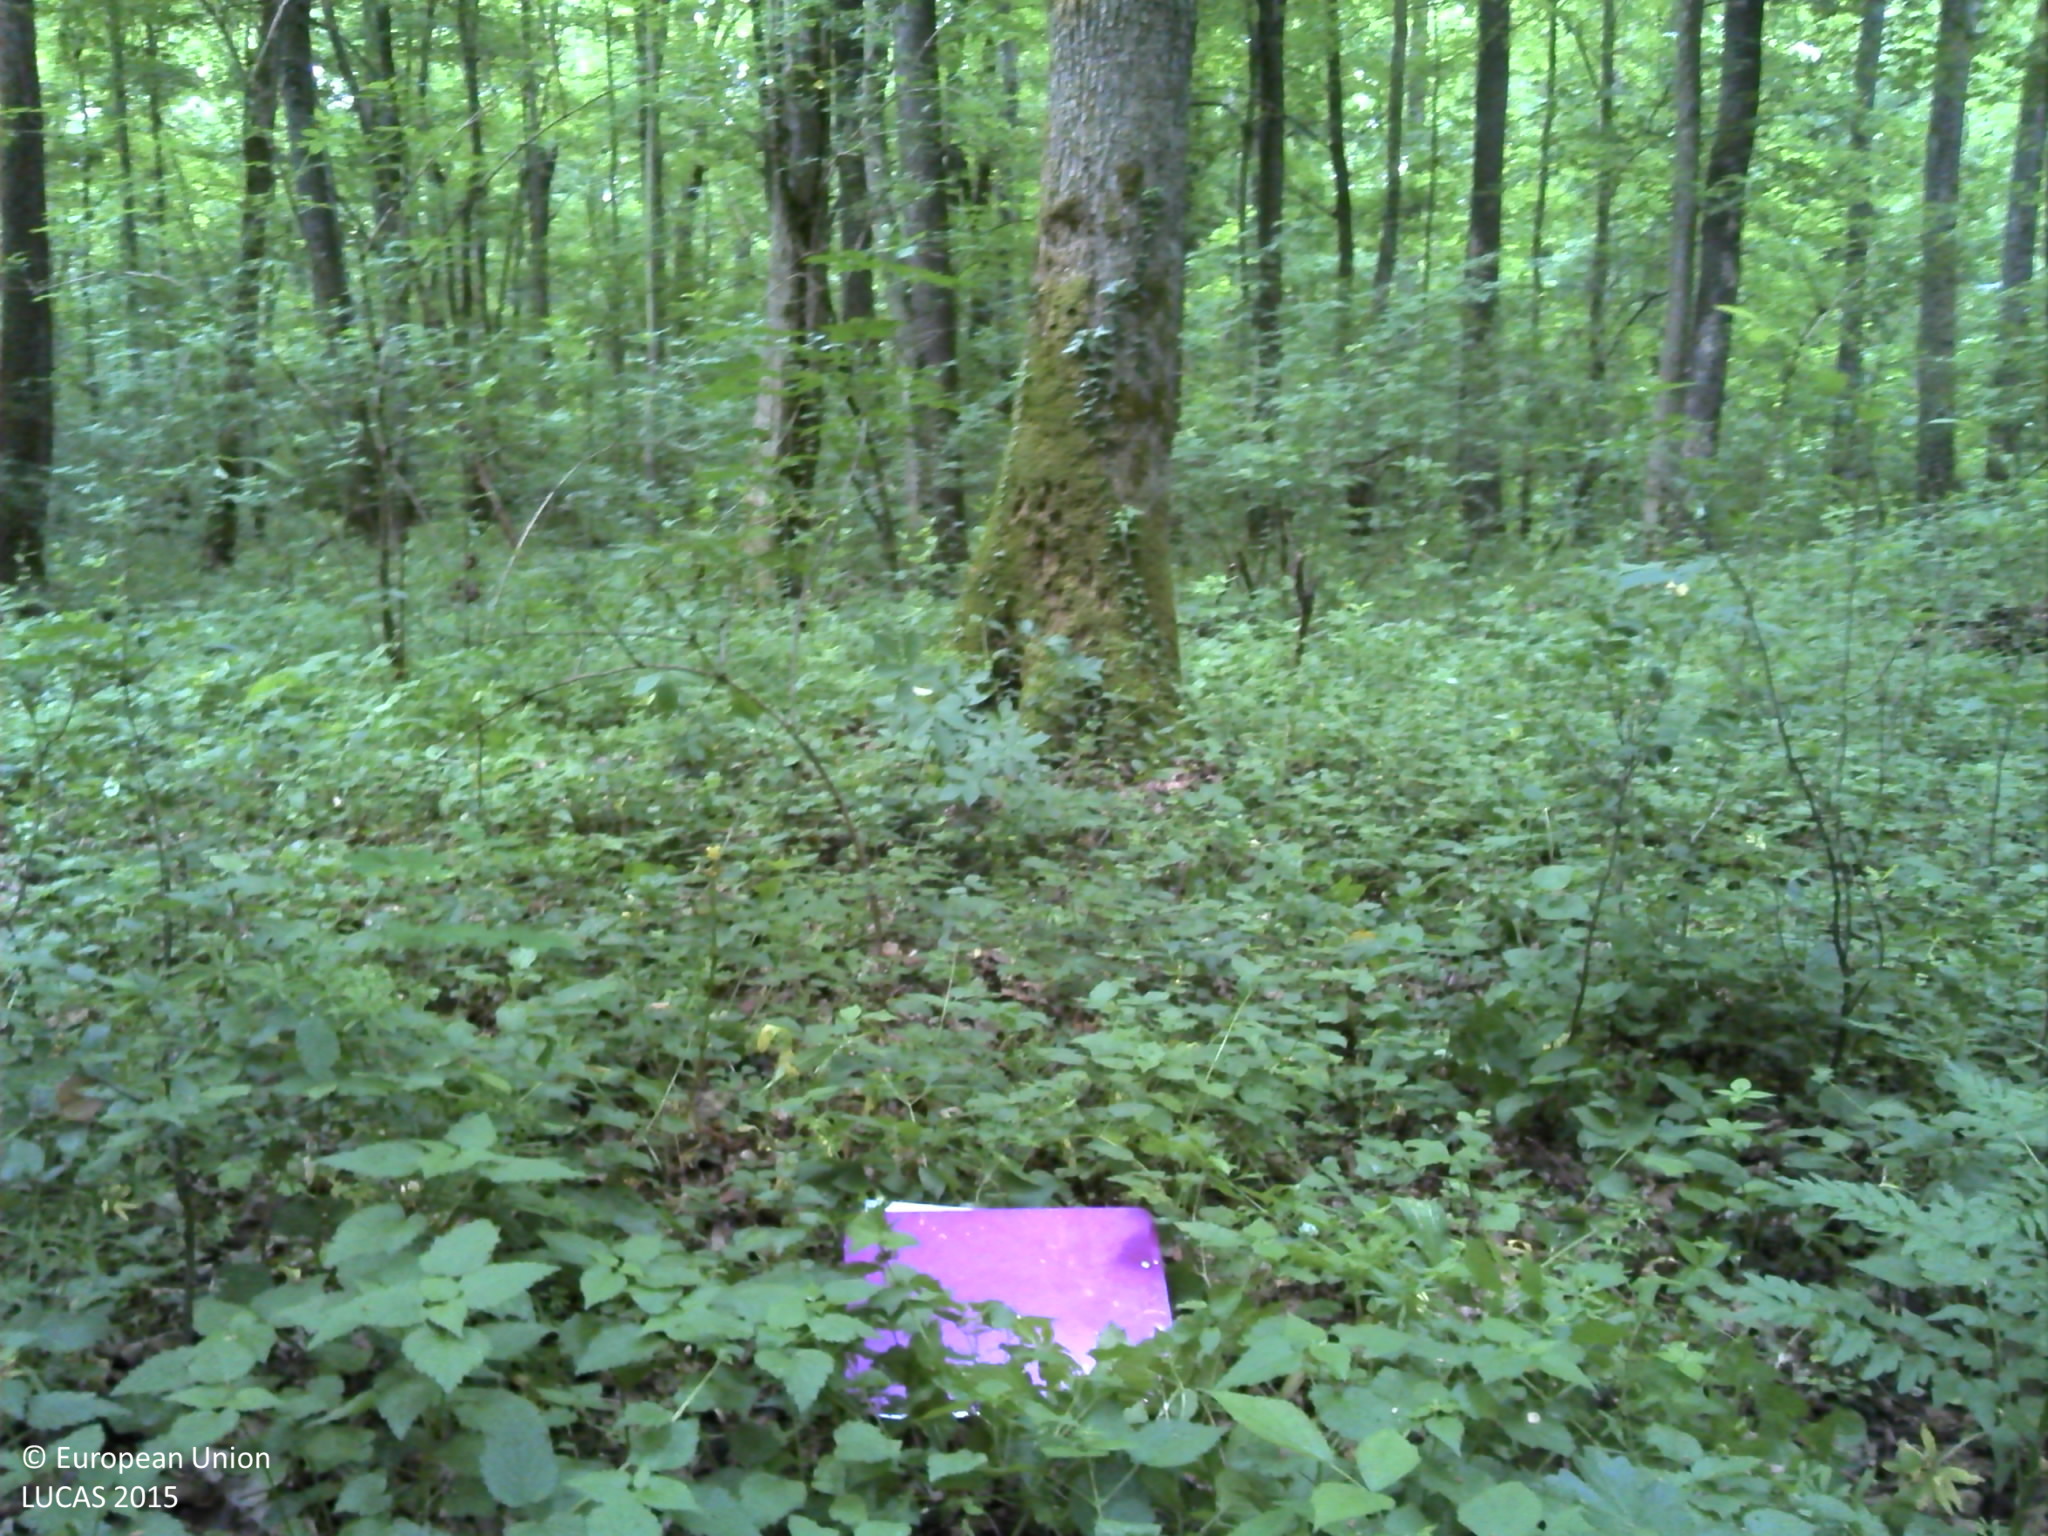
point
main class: Woodland
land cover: Broadleaved woodland
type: acidophilous oak and oak-birch forest
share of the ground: > 75 %
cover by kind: broadleaved forest trees 100 %
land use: Forestry
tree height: > 5 m
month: May
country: HR
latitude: 45.5818
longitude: 18.2204
